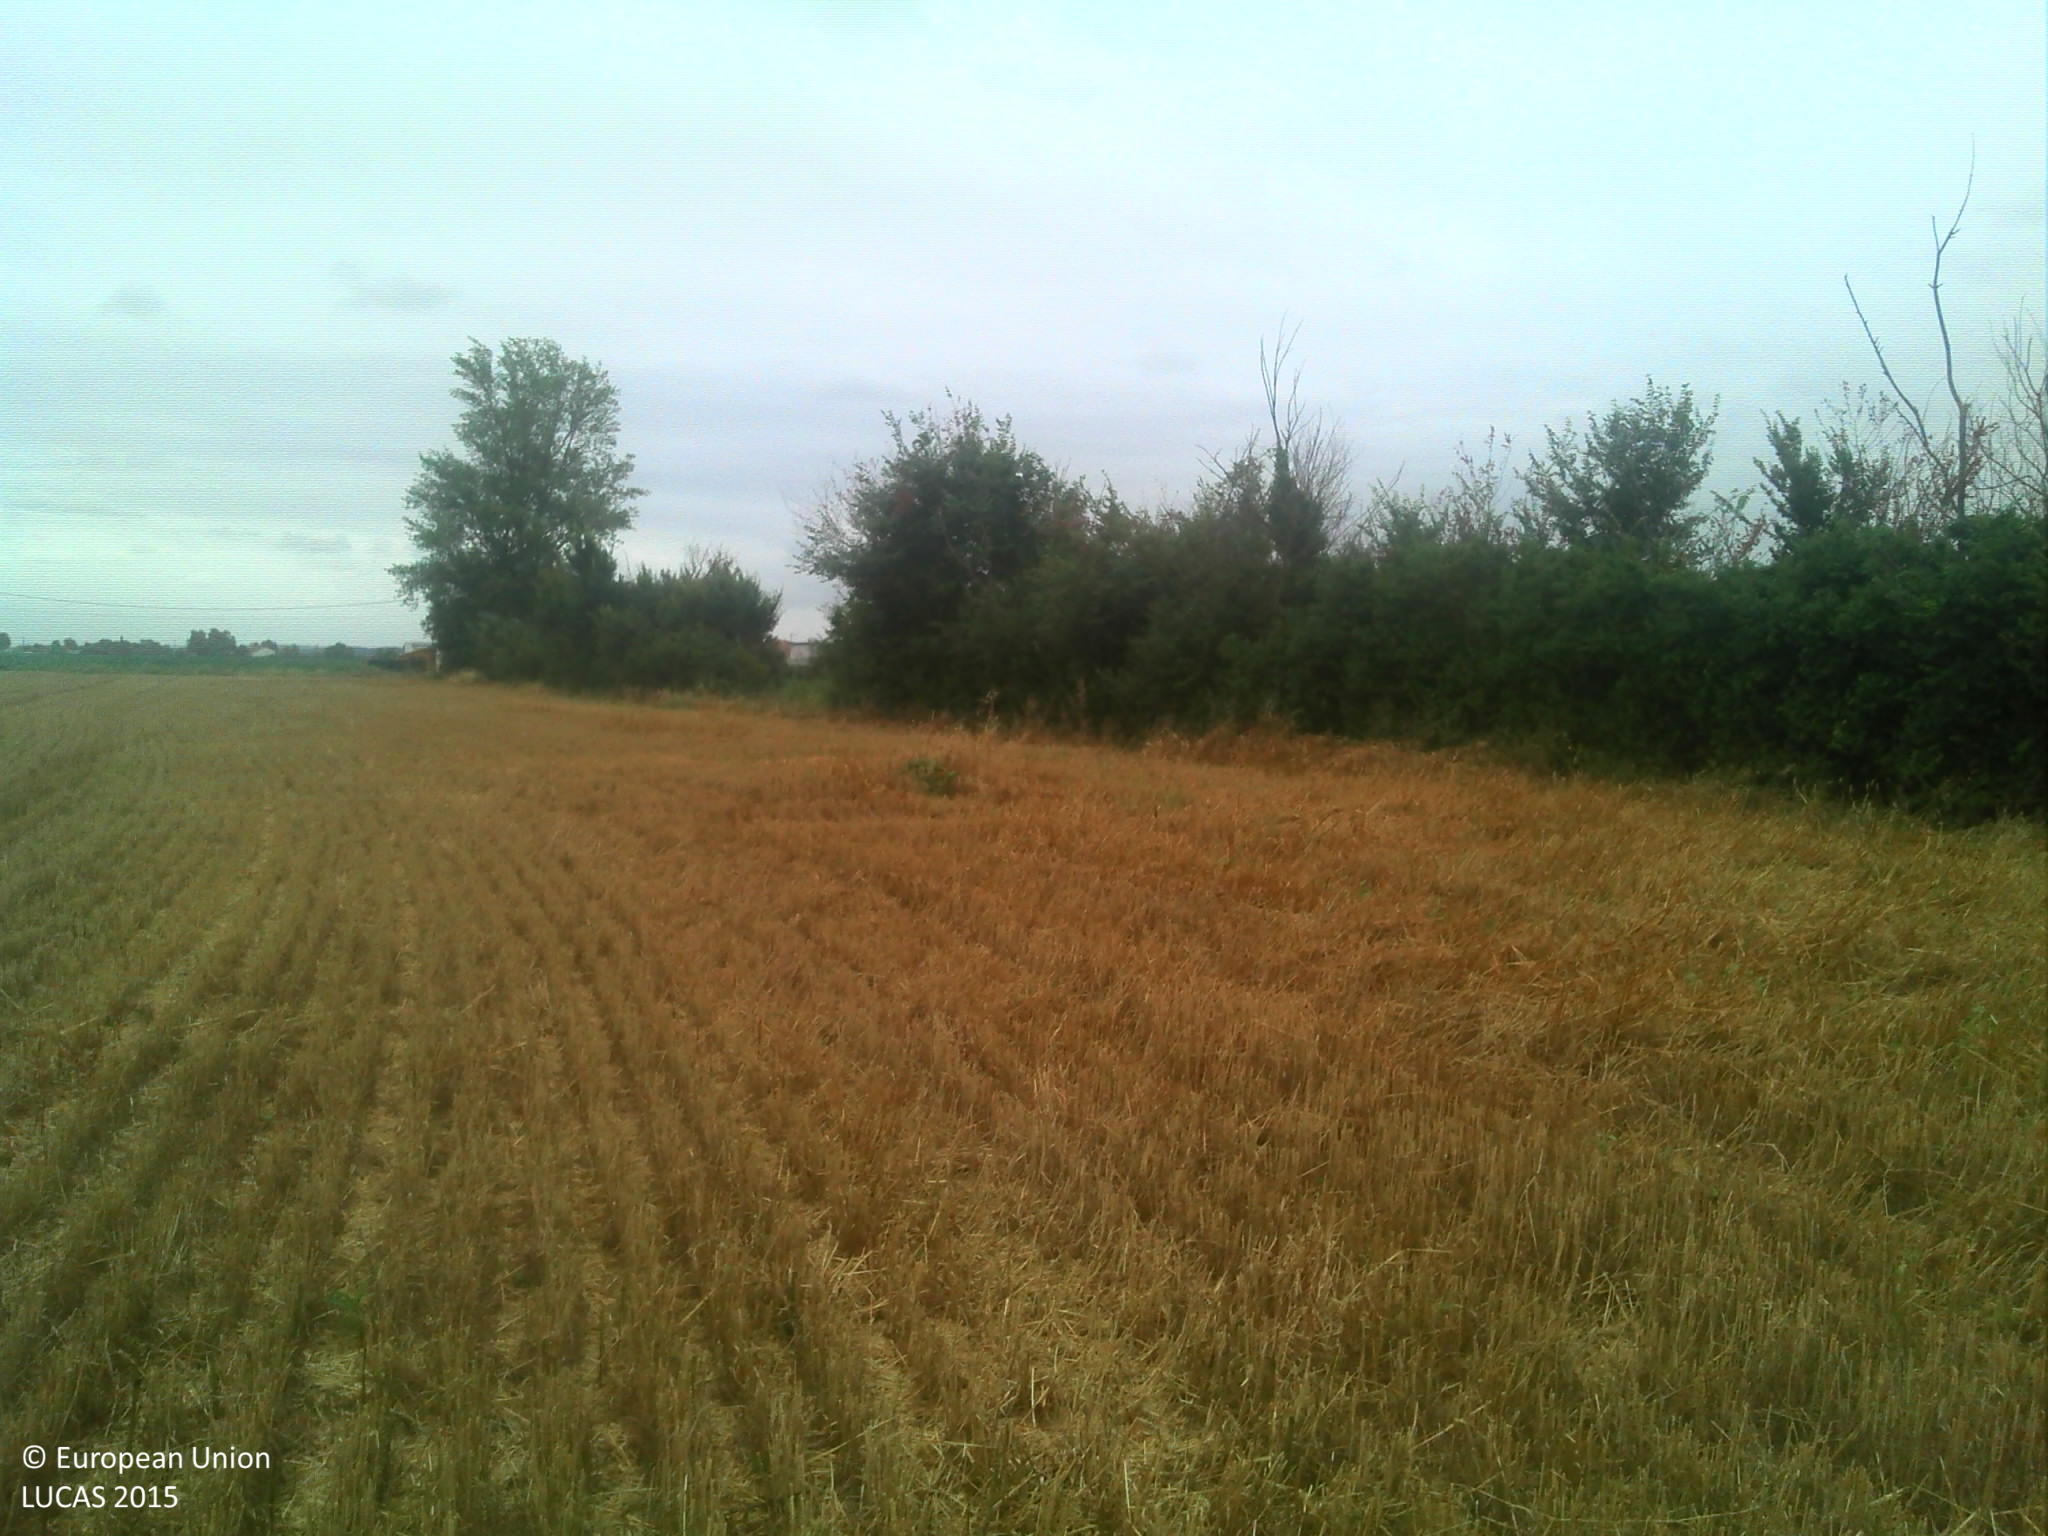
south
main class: Cropland
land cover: Common wheat
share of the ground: > 75 %
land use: Agriculture (excluding fallow land and kitchen gardens)
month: July
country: FR
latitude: 43.3448
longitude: 1.4553
